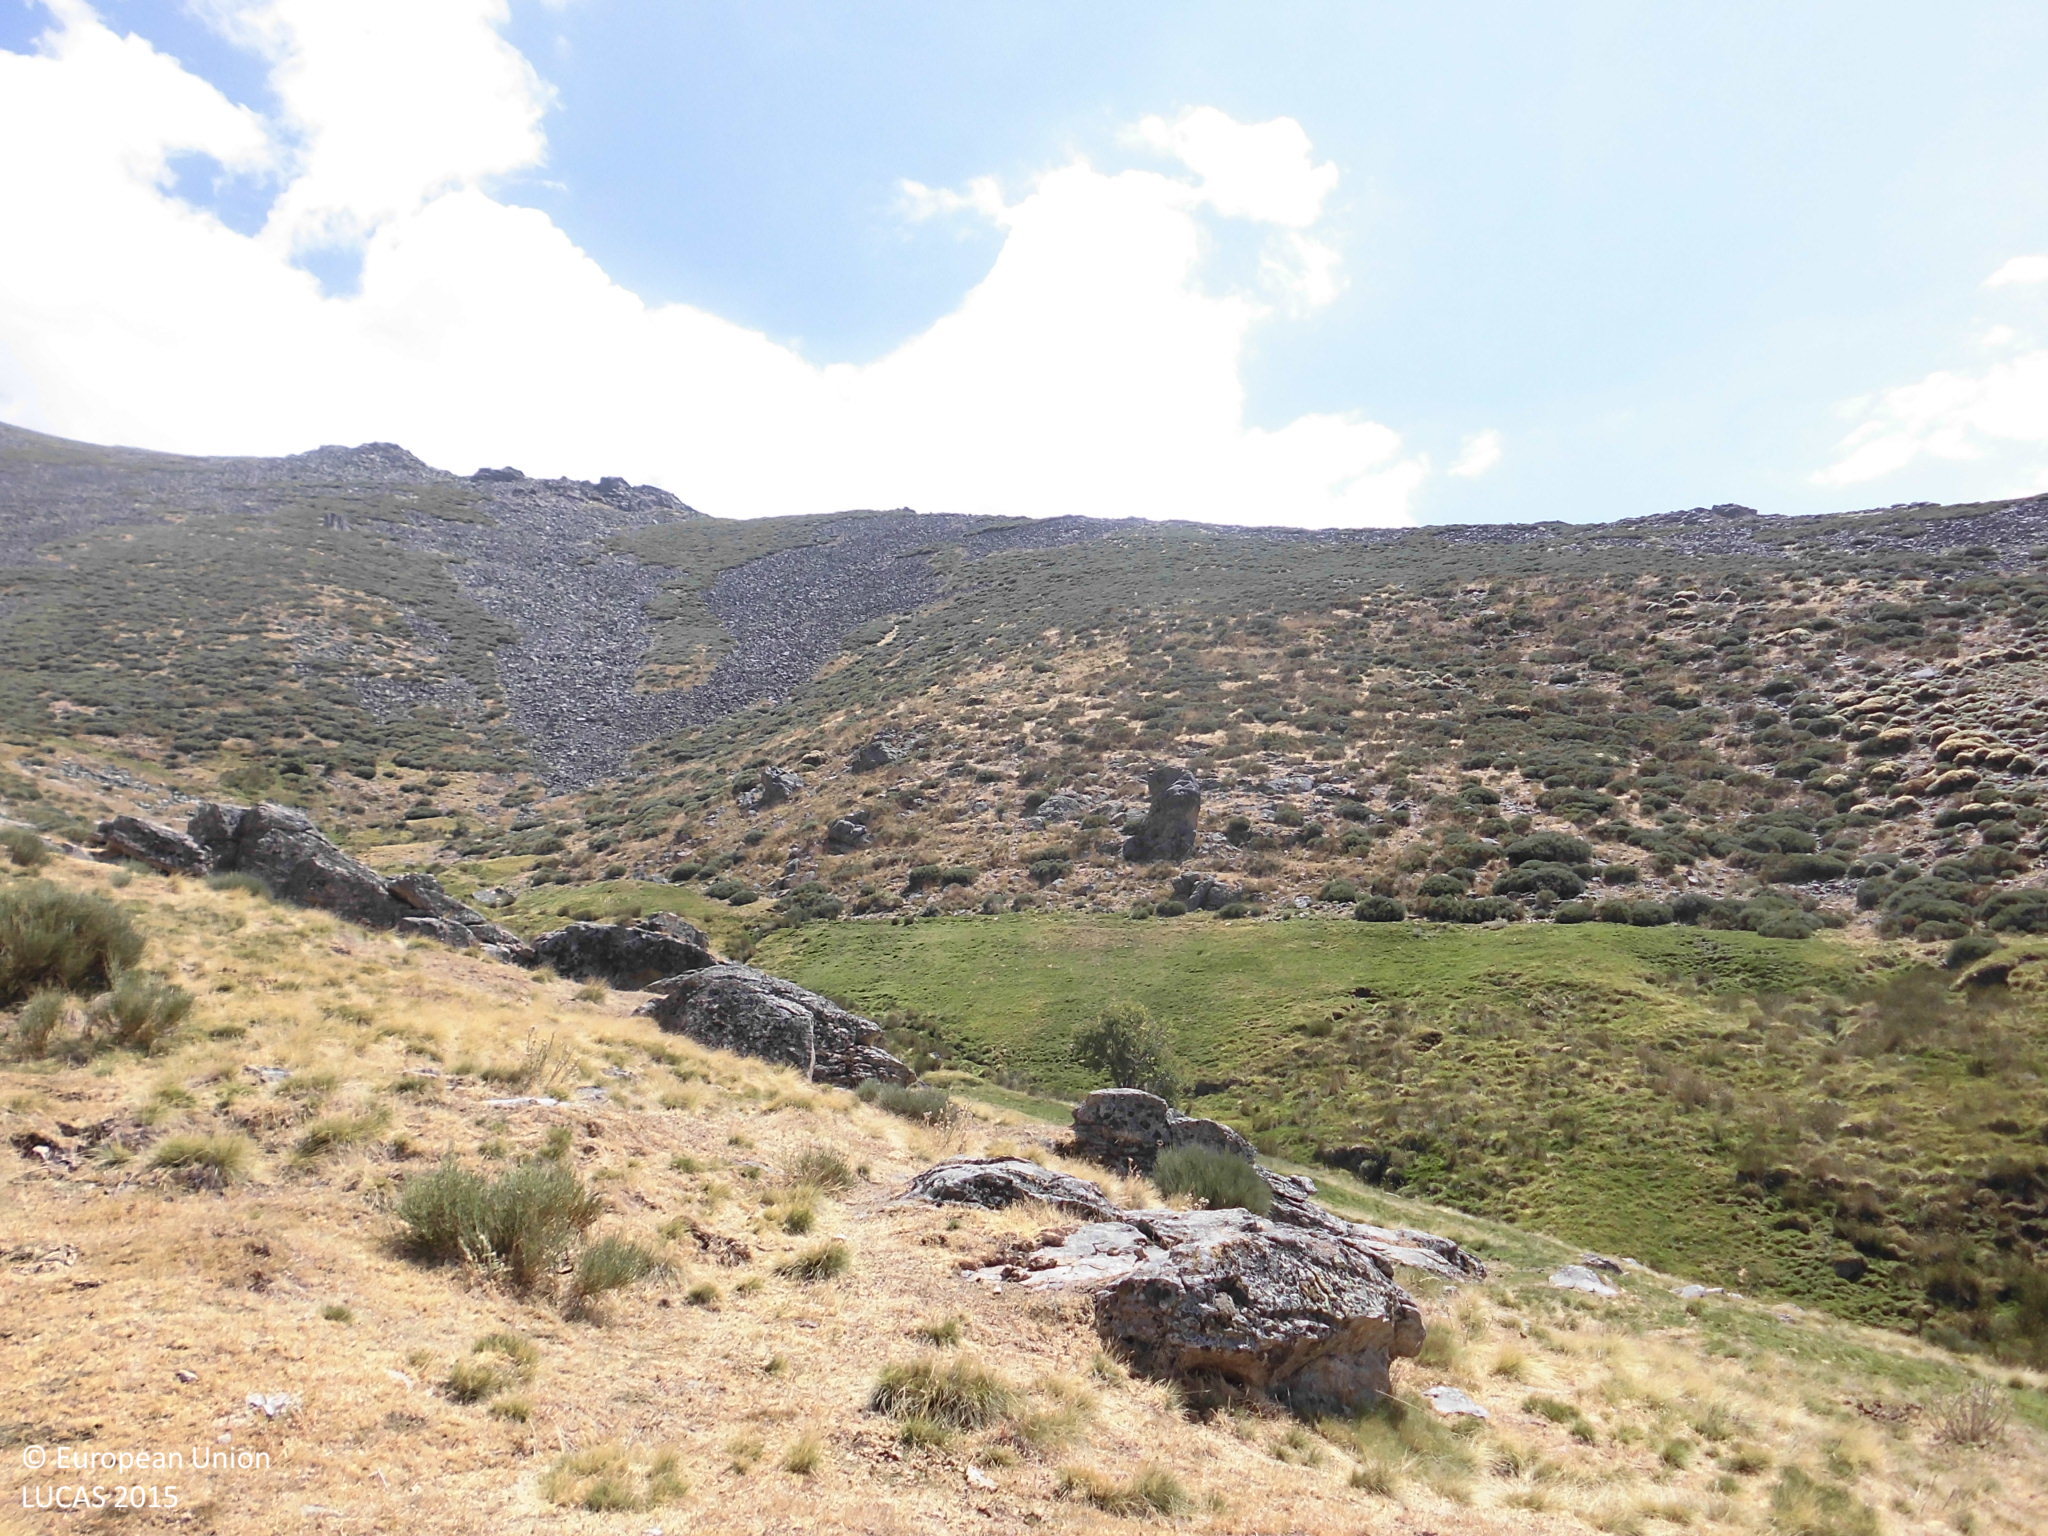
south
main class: Grassland
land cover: Grassland without tree/shrub cover
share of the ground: > 75 %
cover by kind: herbaceous plants 100 %
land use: Agriculture (excluding fallow land and kitchen gardens)
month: July
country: ES
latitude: 40.2620
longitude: -5.4786
